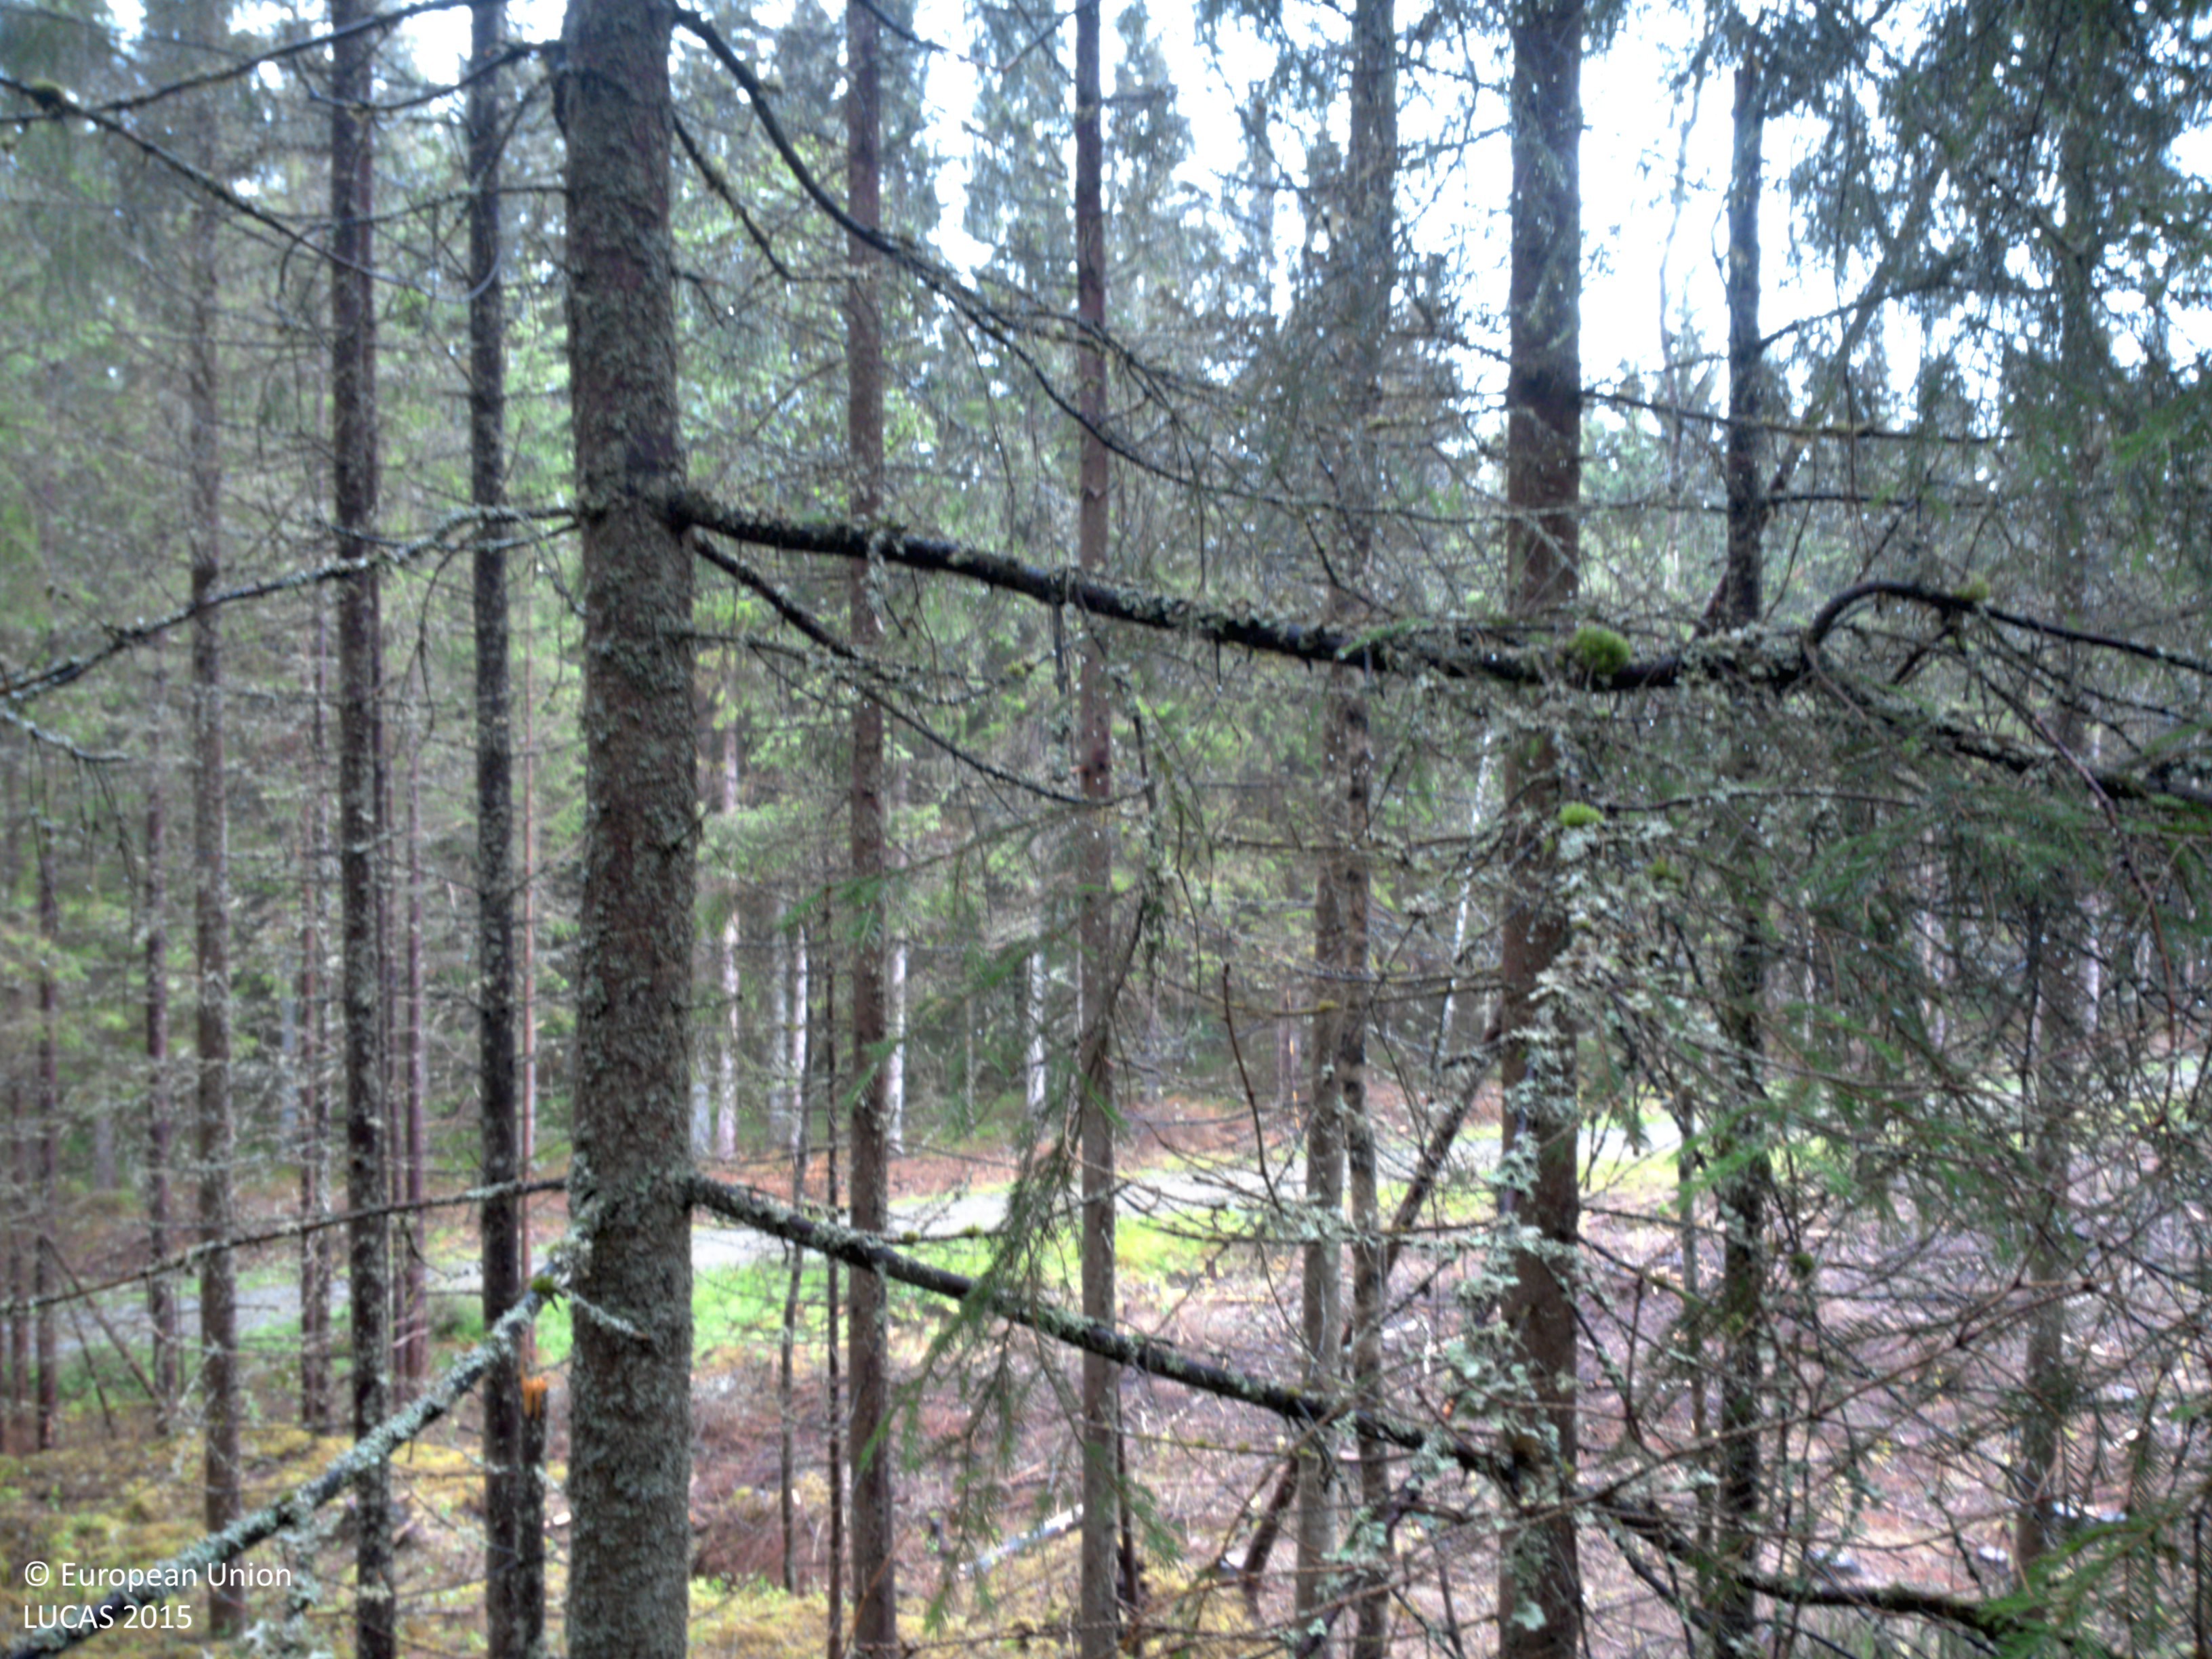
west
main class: Woodland
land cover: Spruce dominated coniferous woodland
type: boreal forest
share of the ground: 50 - 75 %
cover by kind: coniferous forest trees 70 %, lichens and mosses 20 %, shrubs 10 %
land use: Forestry
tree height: > 5 m
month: July
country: SE
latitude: 58.6957
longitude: 11.6012
